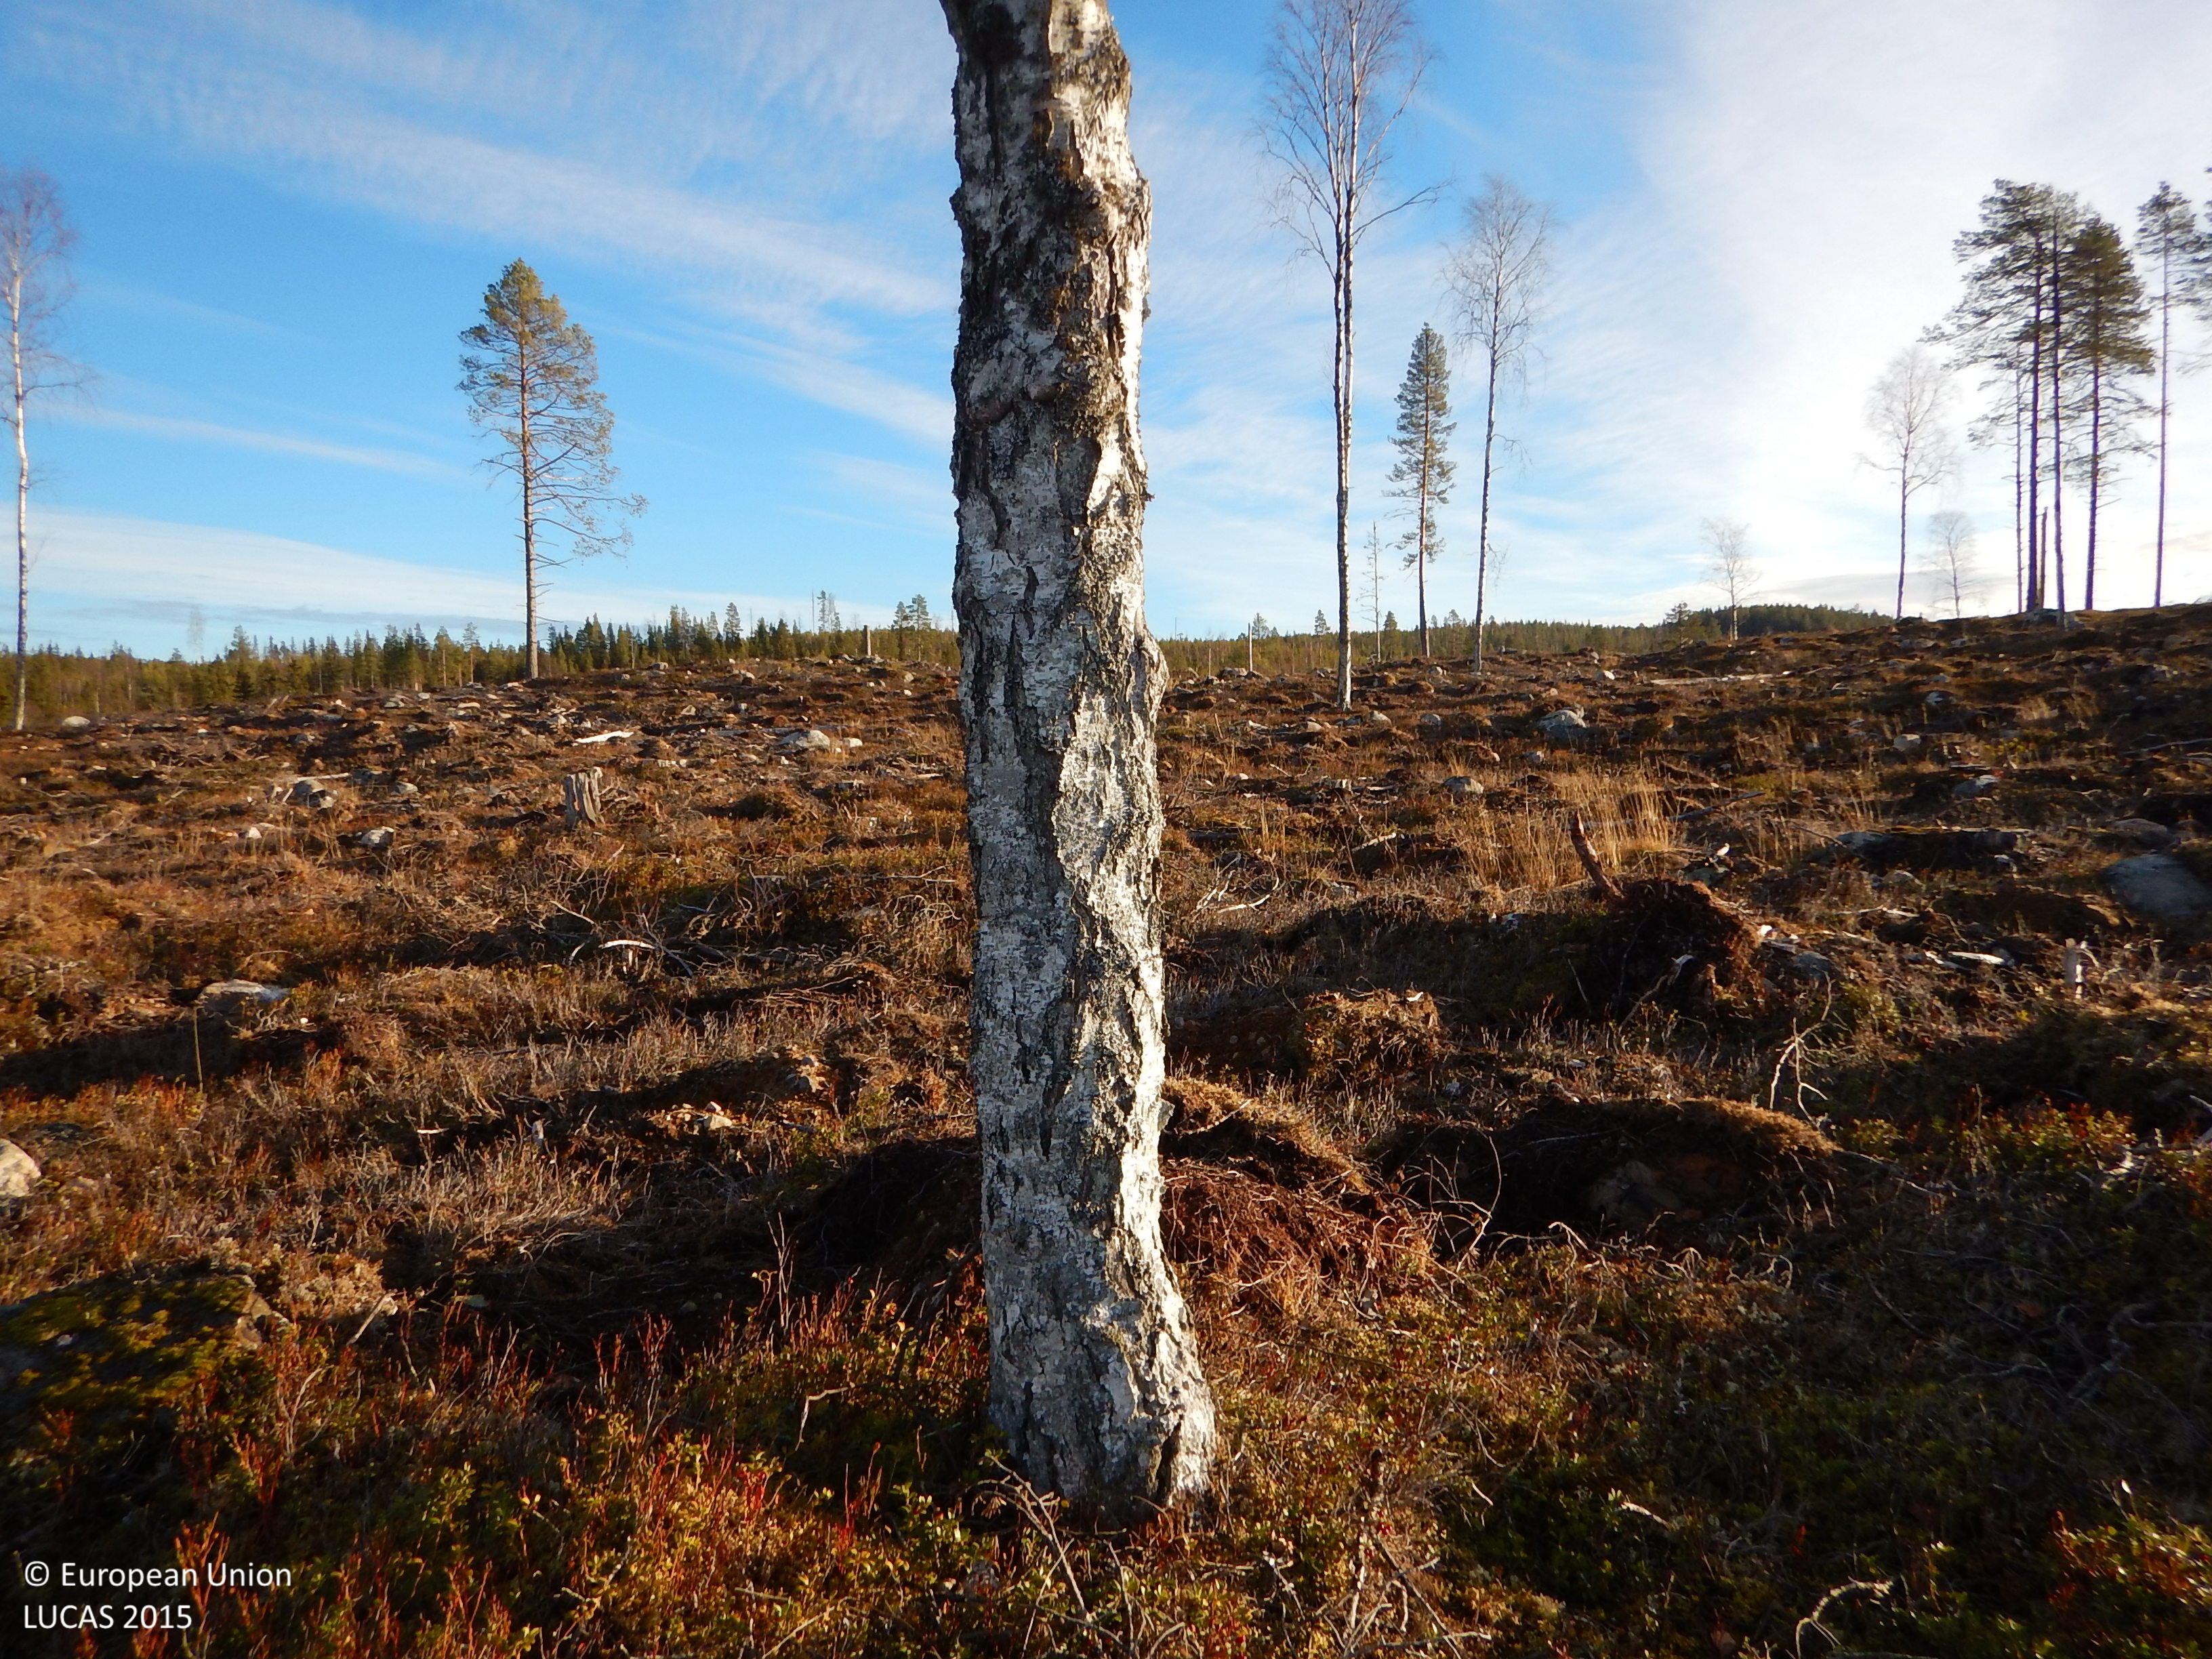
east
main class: Shrubland
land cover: Shrubland with sparse tree cover
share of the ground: 50 - 75 %
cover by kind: shrubs 50 %, herbaceous plants 20 %, lichens and mosses 15 %, coniferous forest trees 5 %, consolidated bare surface 5 %, unconsolidated bare surface 5 %
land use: Forestry
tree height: < 5 m
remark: Clear cut
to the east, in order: Shrubland with sparse tree cover; Rivers and streams; Shrubland with sparse tree cover; Other mixed woodland; Grass margins; Paved roads, cycling and walking lanes
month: November
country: SE
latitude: 65.3389
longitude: 20.6015
